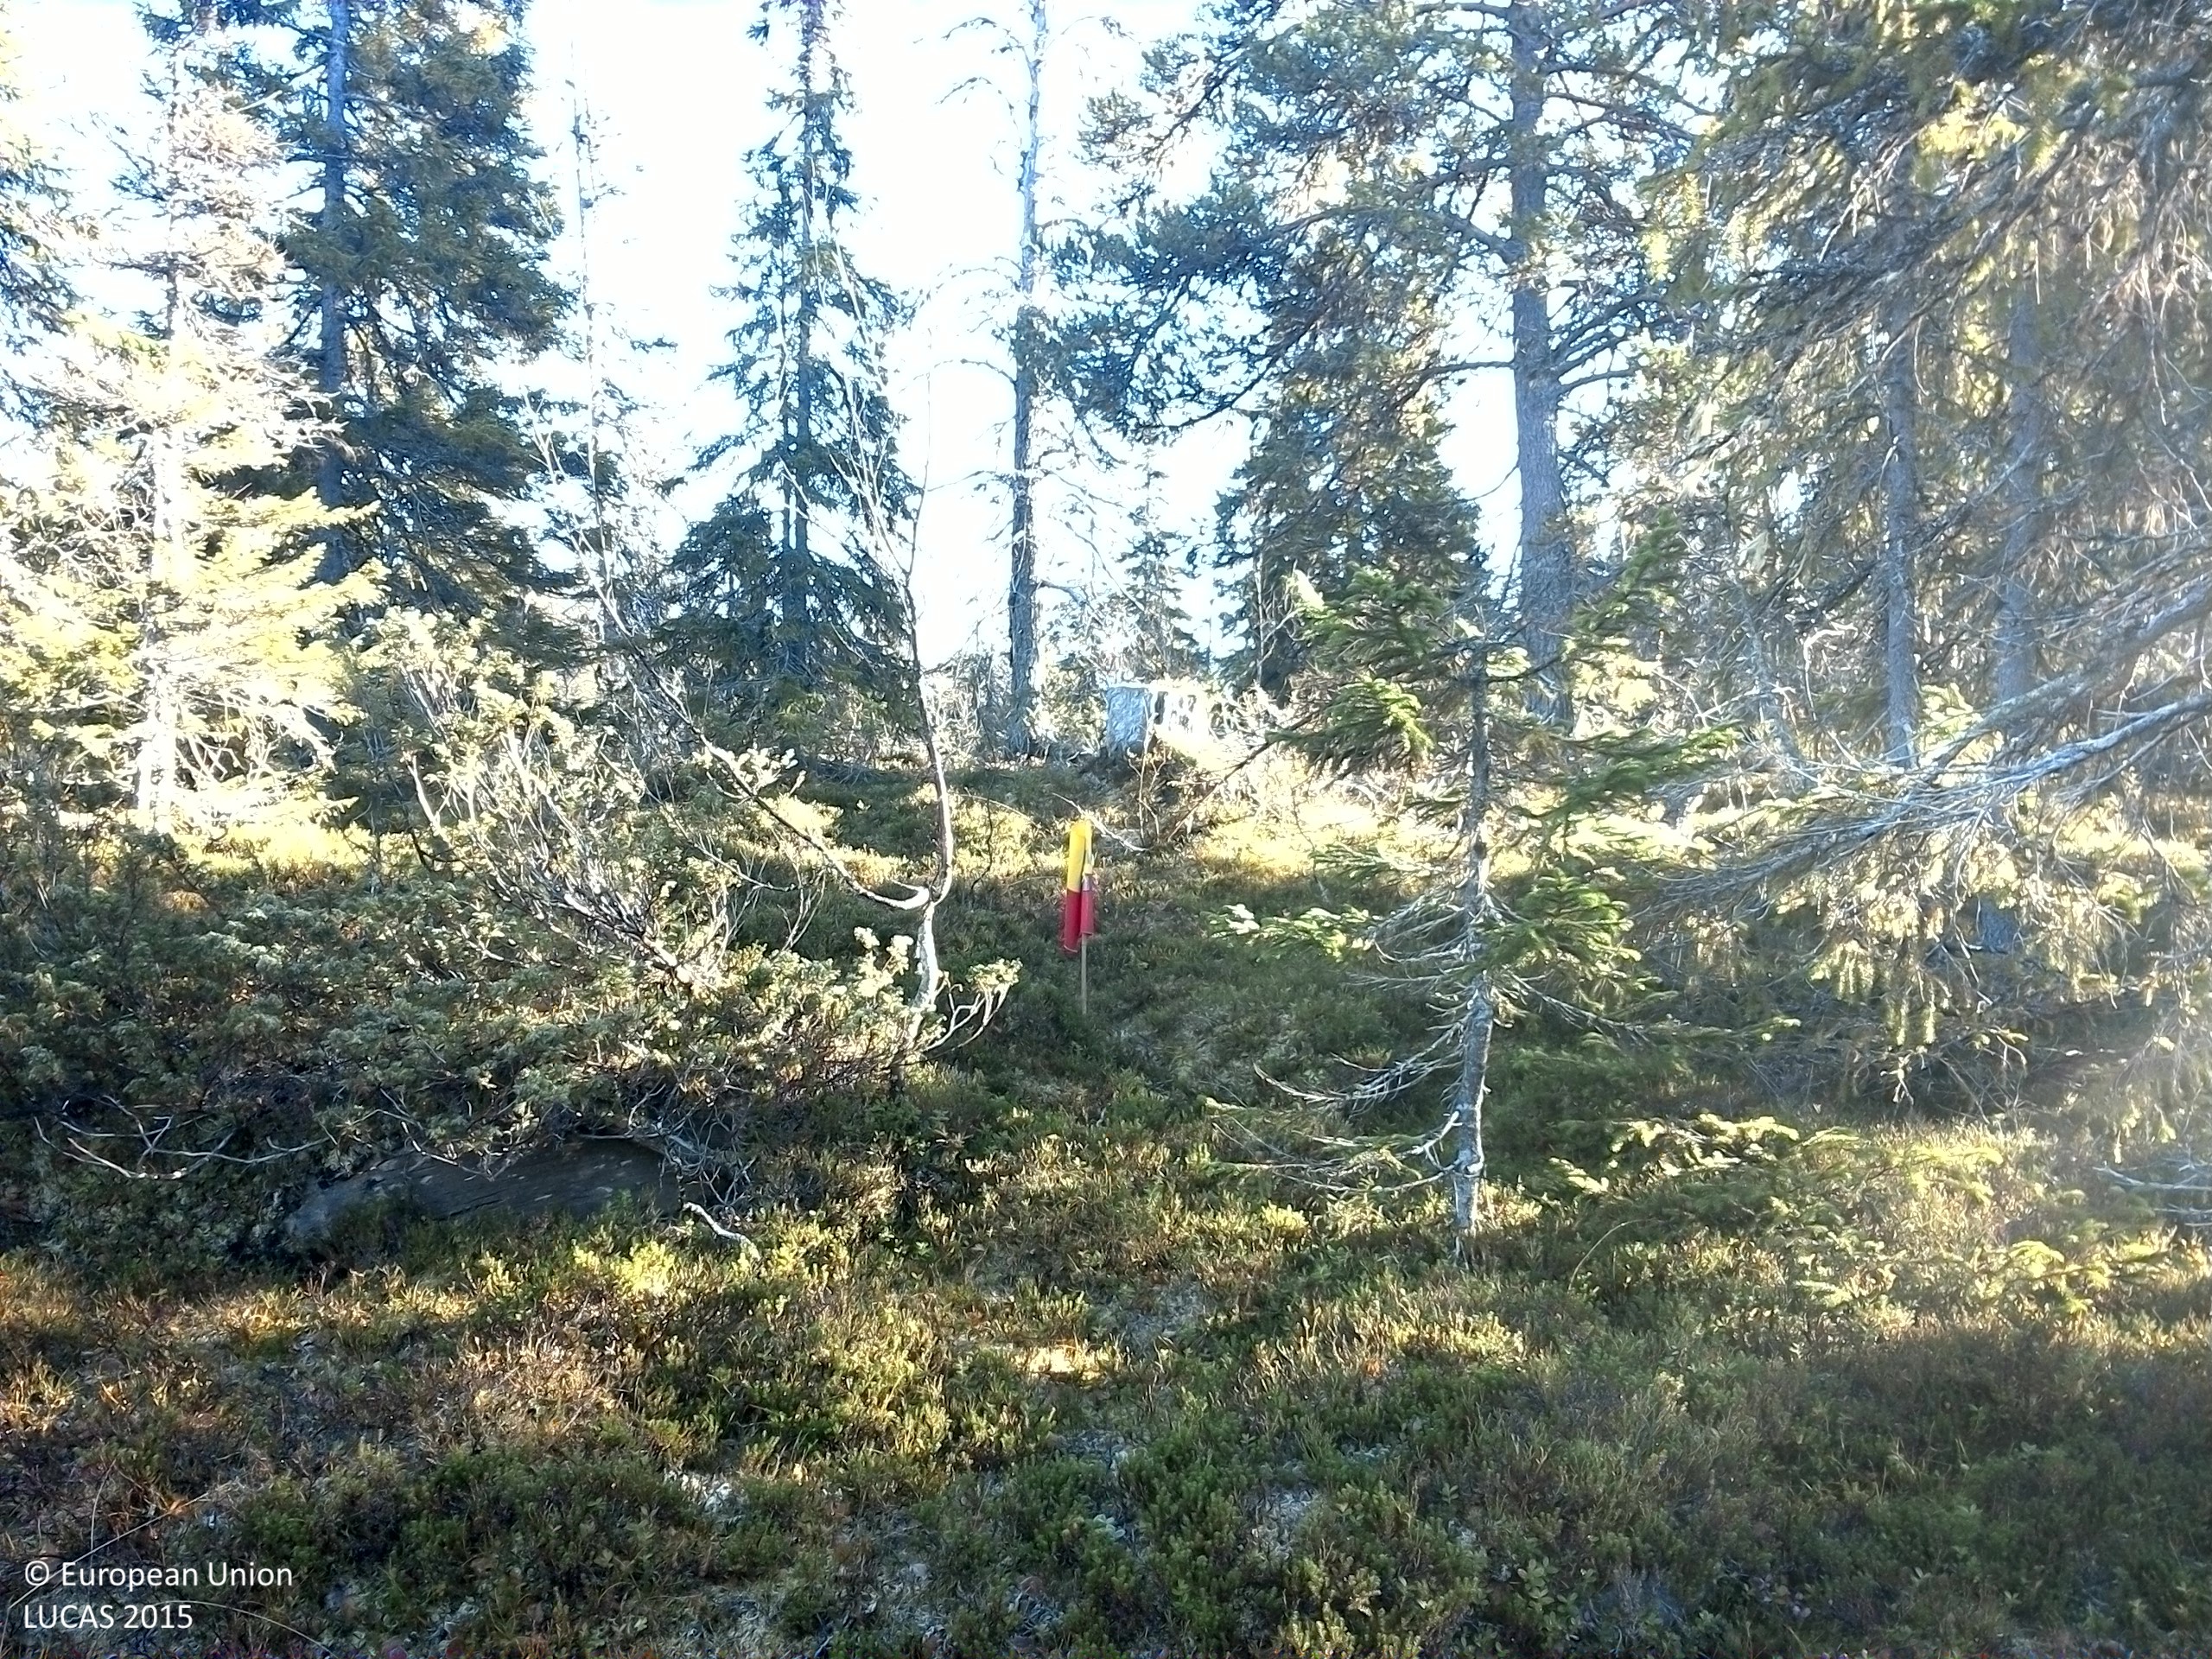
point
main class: Woodland
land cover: Spruce dominated mixed woodland
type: boreal forest
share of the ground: 50 - 75 %
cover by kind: coniferous forest trees 35 %, shrubs 30 %, lichens and mosses 20 %, broadleaved forest trees 15 %
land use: Forestry
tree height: > 5 m
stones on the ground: < 10 %
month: October
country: SE
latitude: 64.6882
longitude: 14.7722
